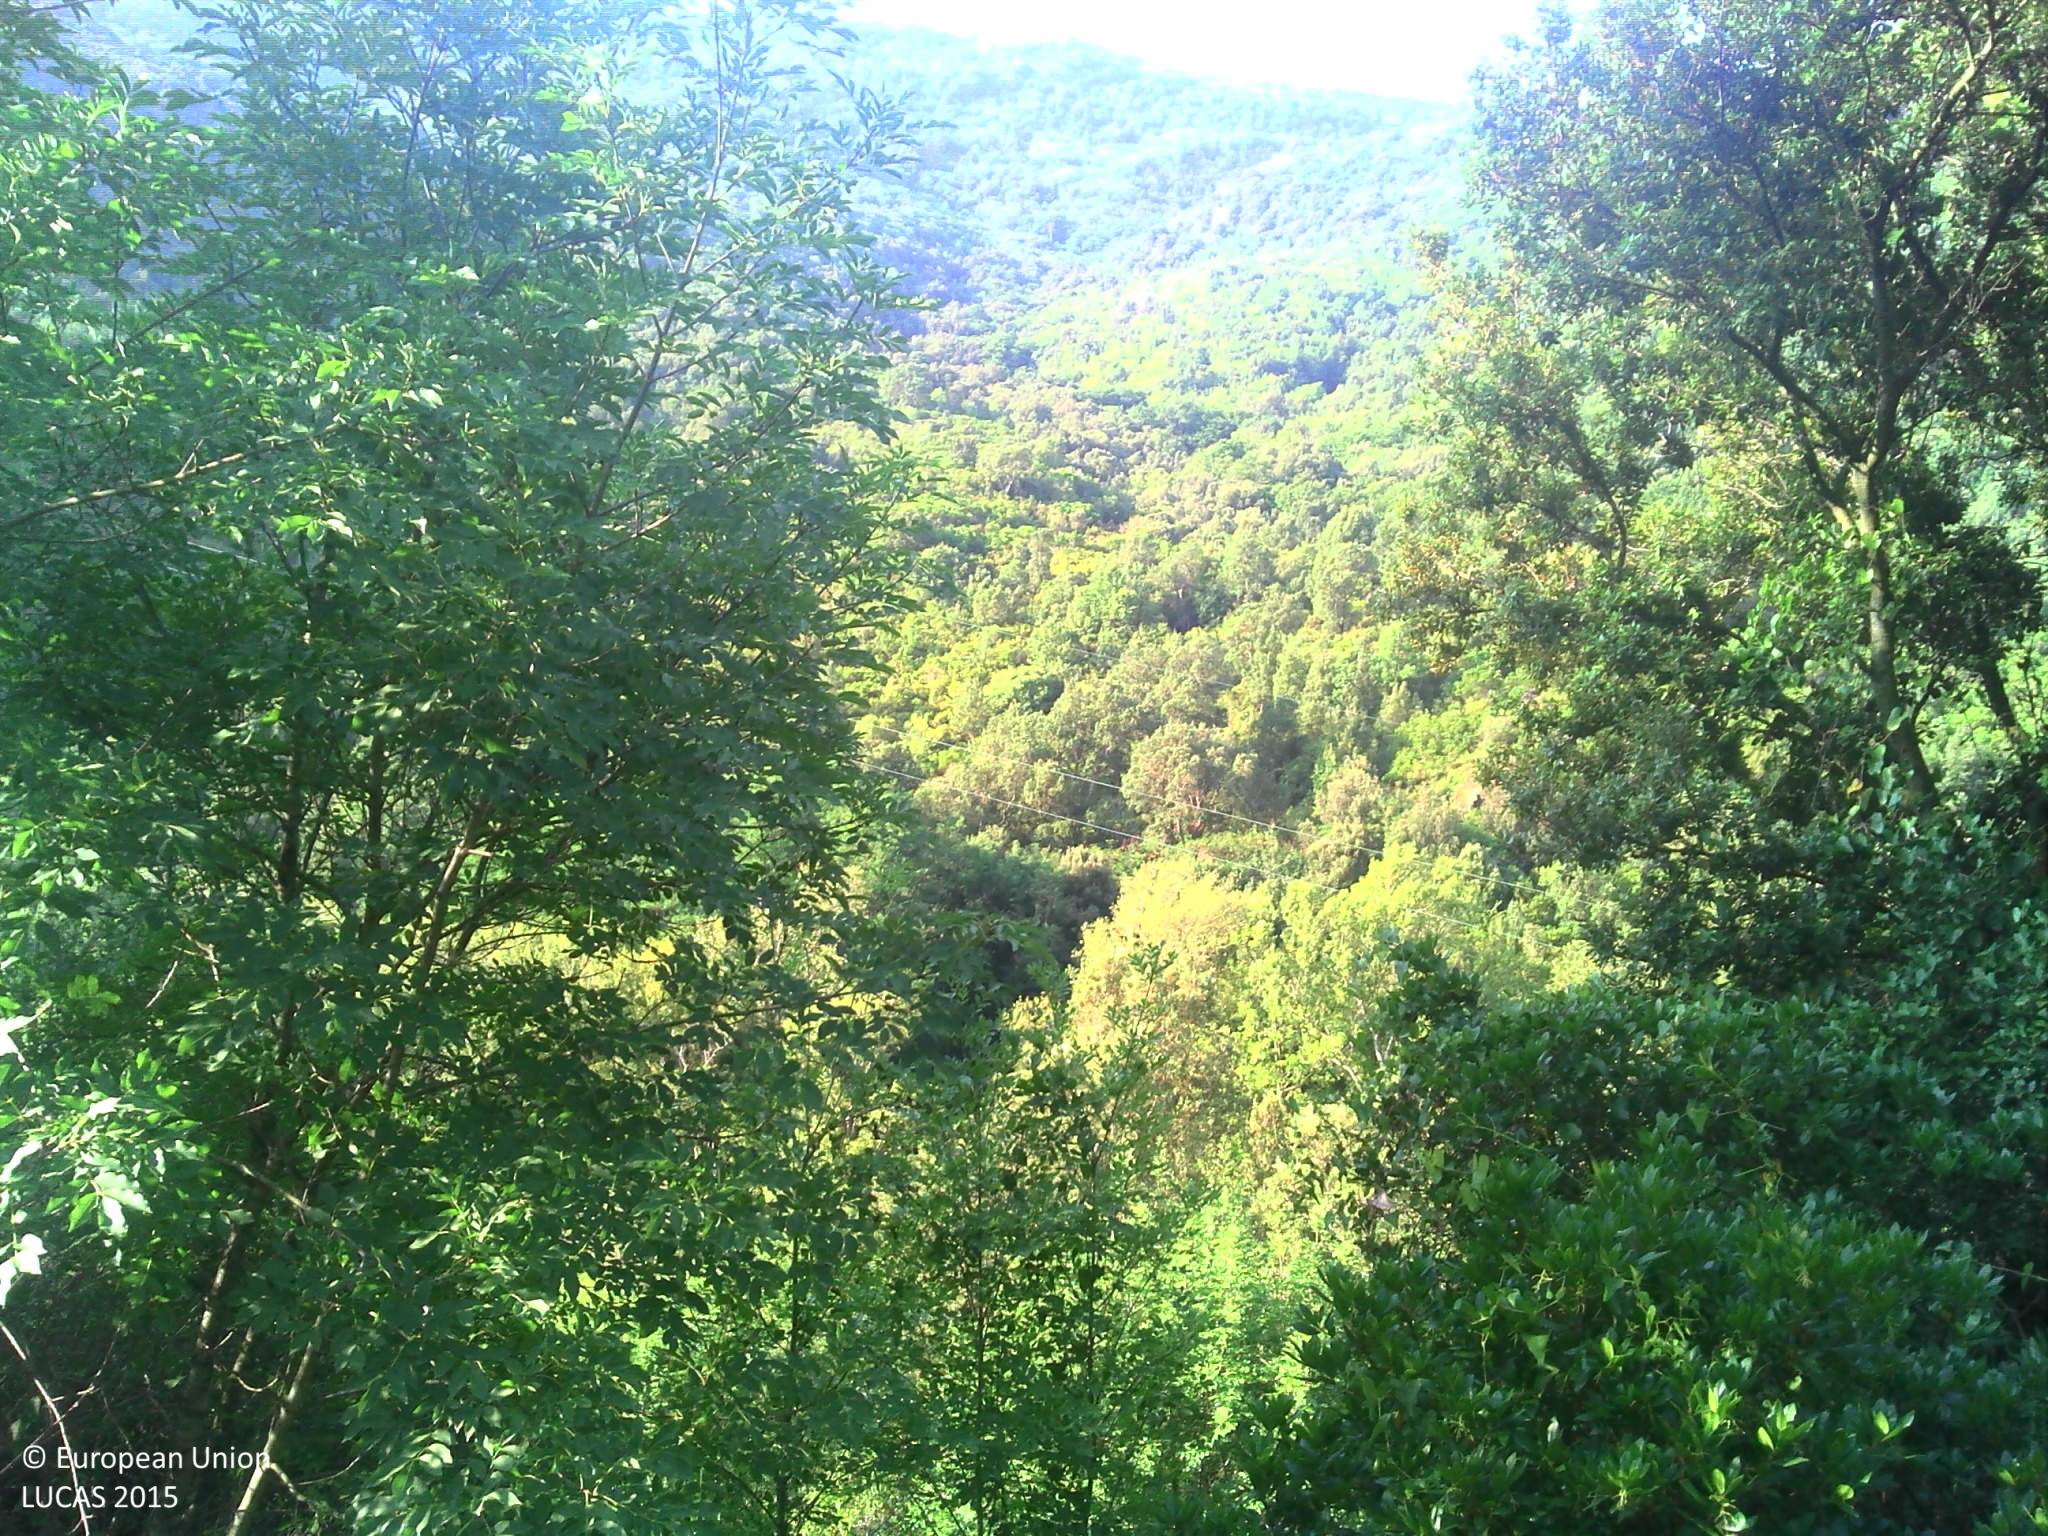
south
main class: Shrubland
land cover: Shrubland without tree cover
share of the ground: > 75 %
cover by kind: shrubs 80 %, consolidated bare surface 20 %
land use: Semi-natural and natural areas not in use
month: July
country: FR
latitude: 42.5073
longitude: 9.3330
